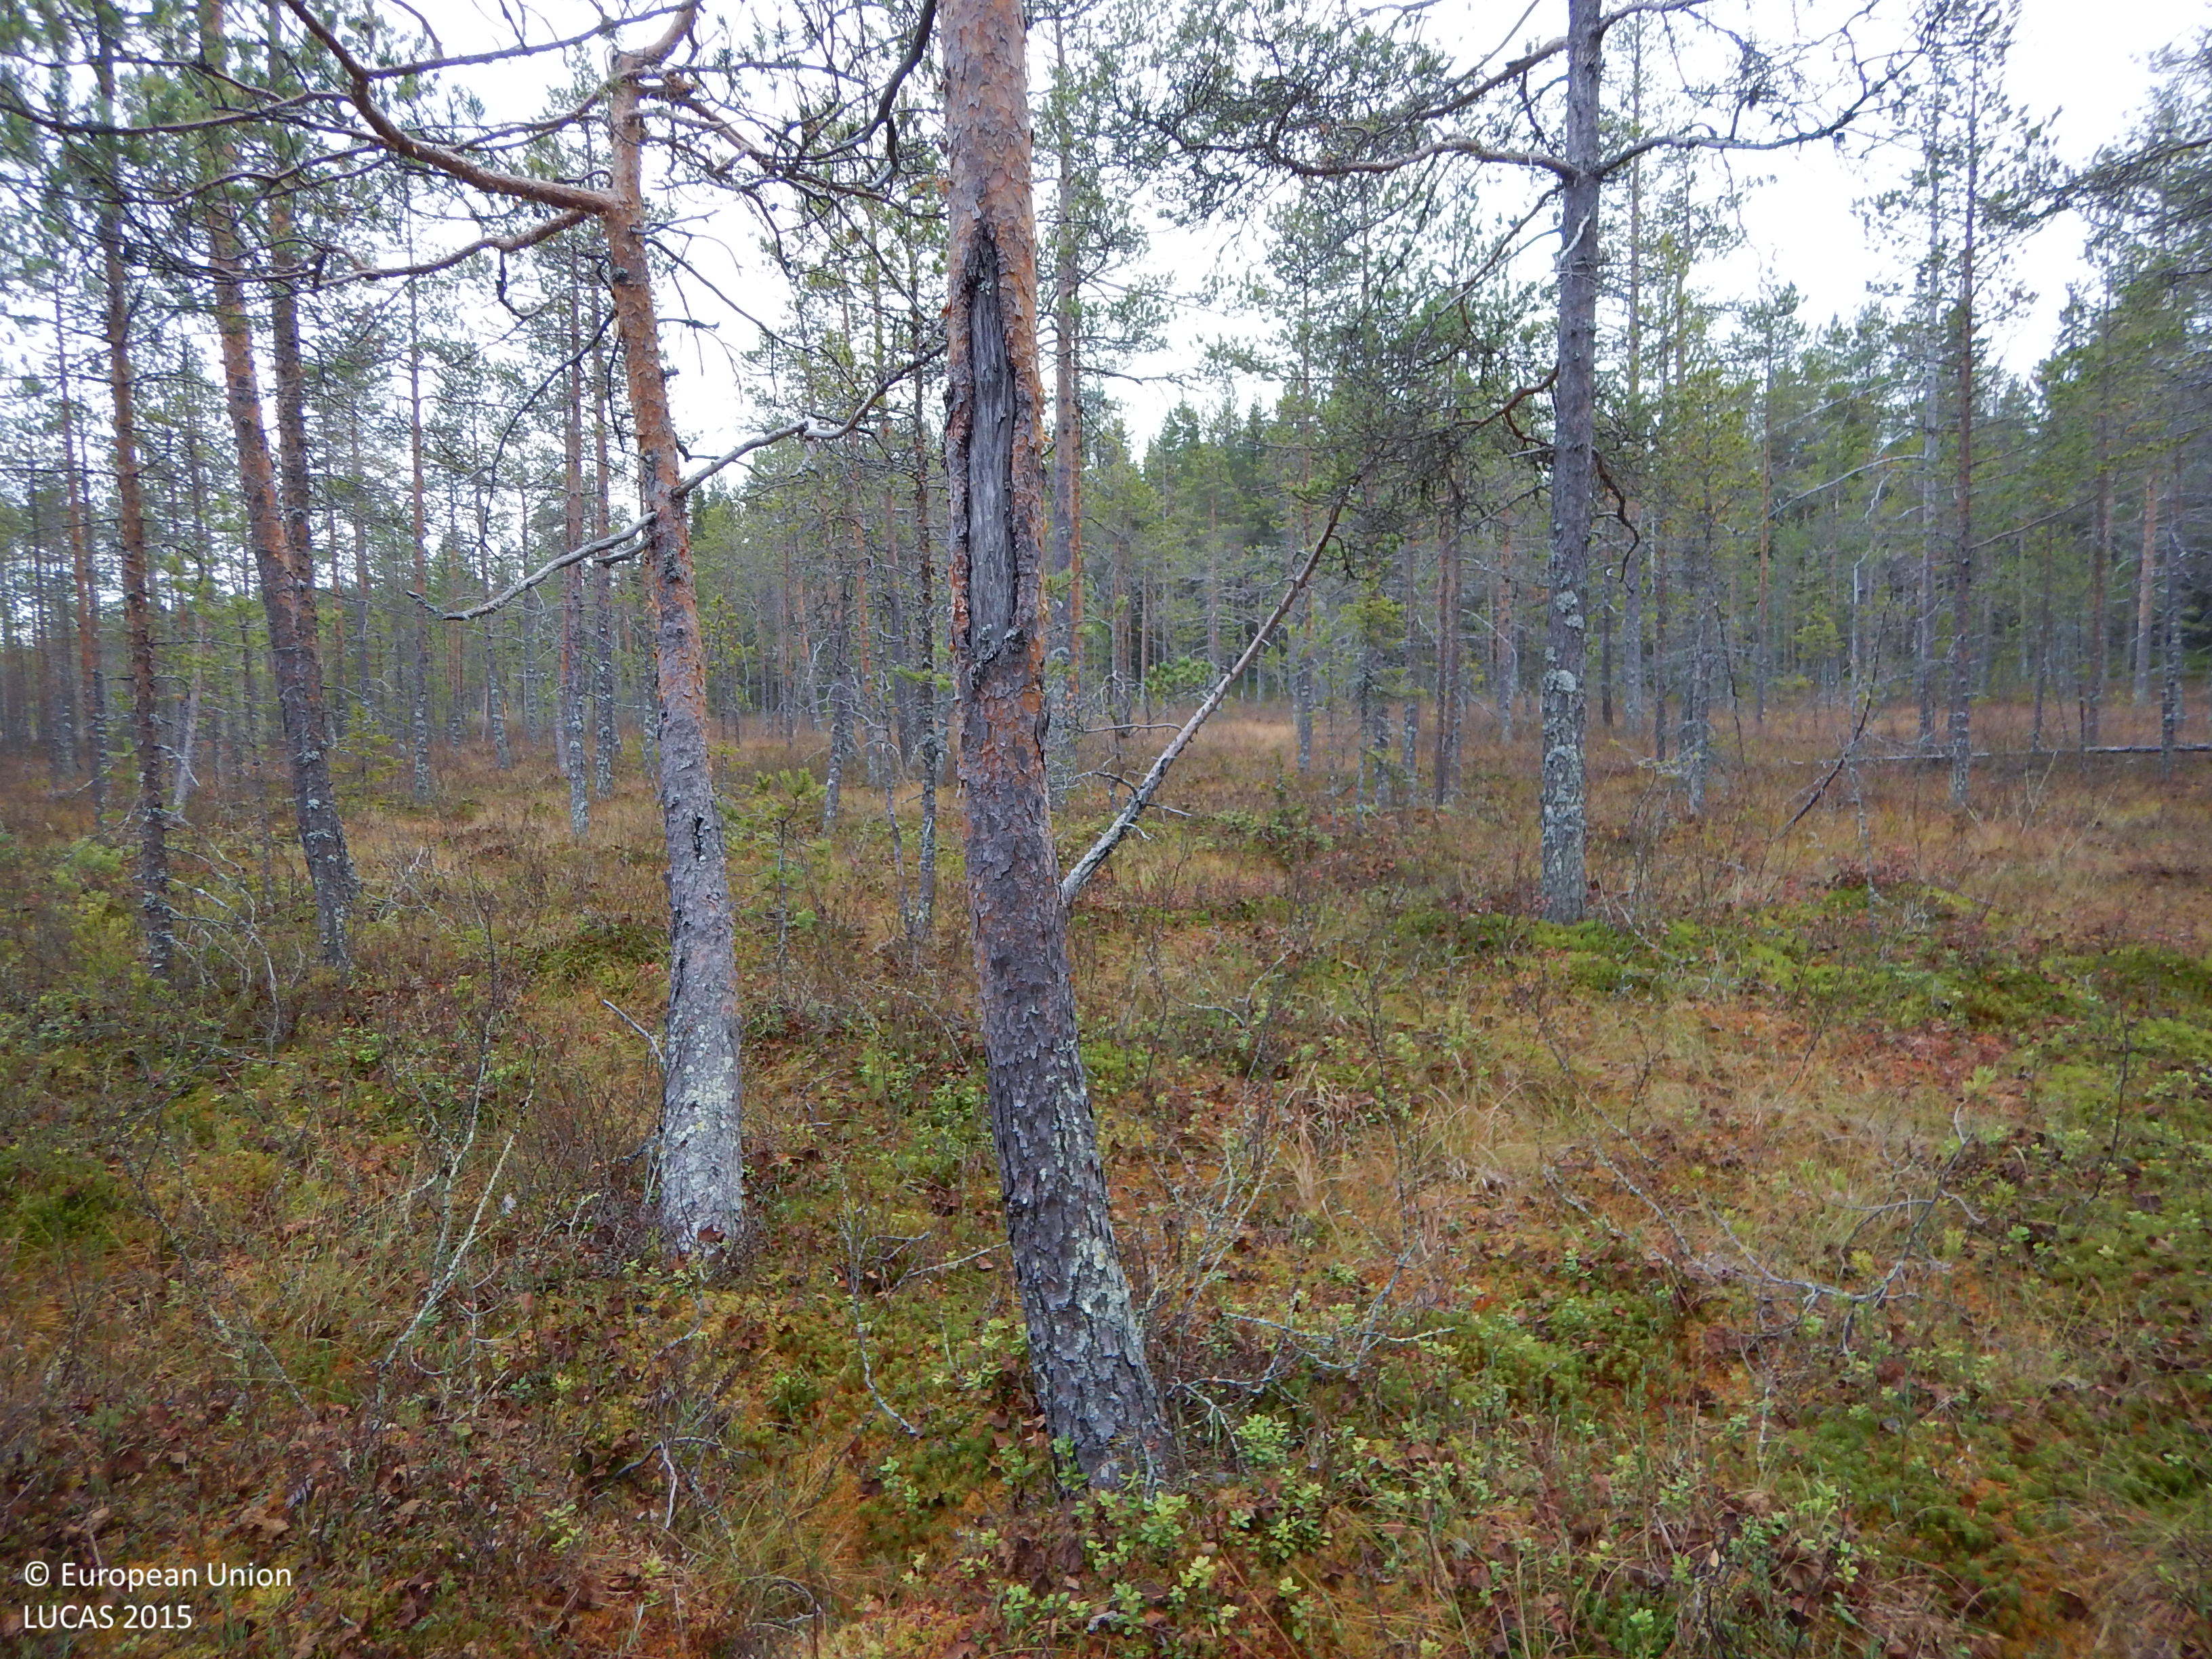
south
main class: Woodland
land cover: Pine dominated coniferous woodland
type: mire and swamp forests
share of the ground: 25 - 50 %
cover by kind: coniferous forest trees 40 %, lichens and mosses 30 %, shrubs 20 %, herbaceous plants 10 %
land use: Semi-natural and natural areas not in use
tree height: > 5 m
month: October
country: SE
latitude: 65.1010
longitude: 21.1515
